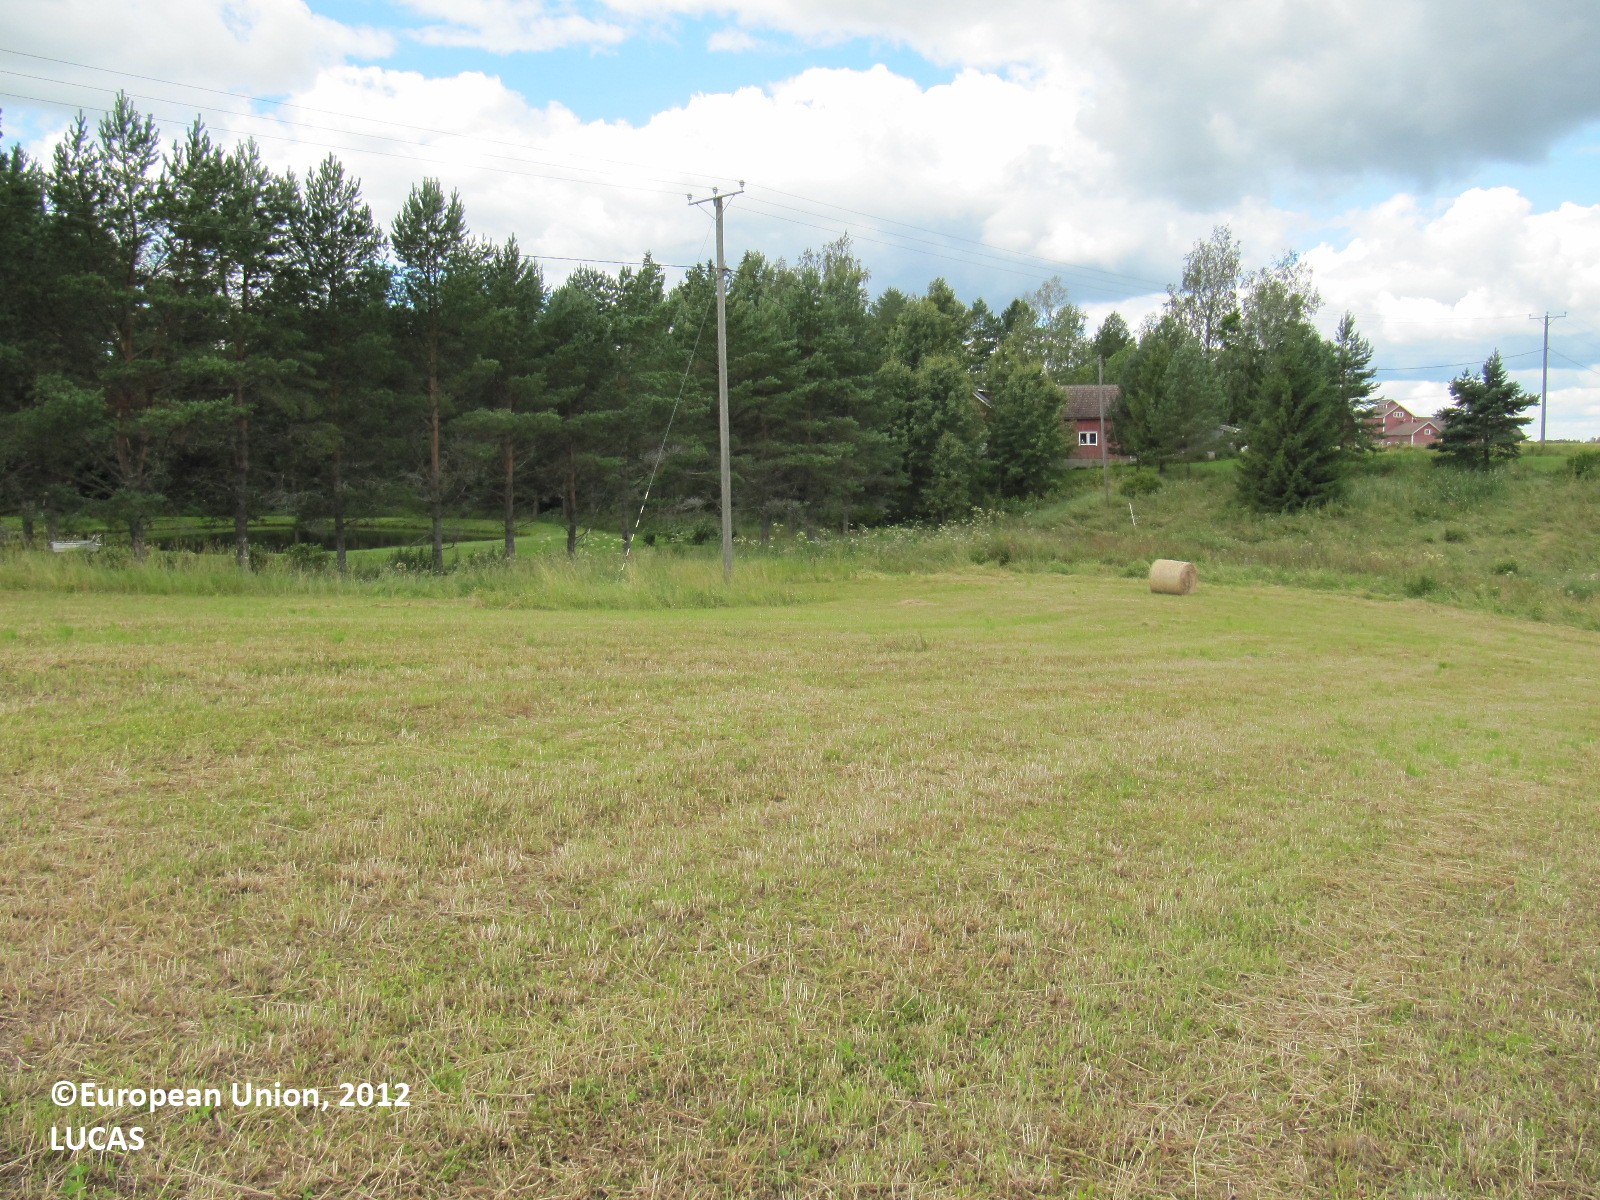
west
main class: Grassland
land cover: Grassland without tree/shrub cover
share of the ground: > 75 %
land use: Agriculture (excluding fallow land and kitchen gardens)
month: August
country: FI
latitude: 60.5389
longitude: 23.2606
